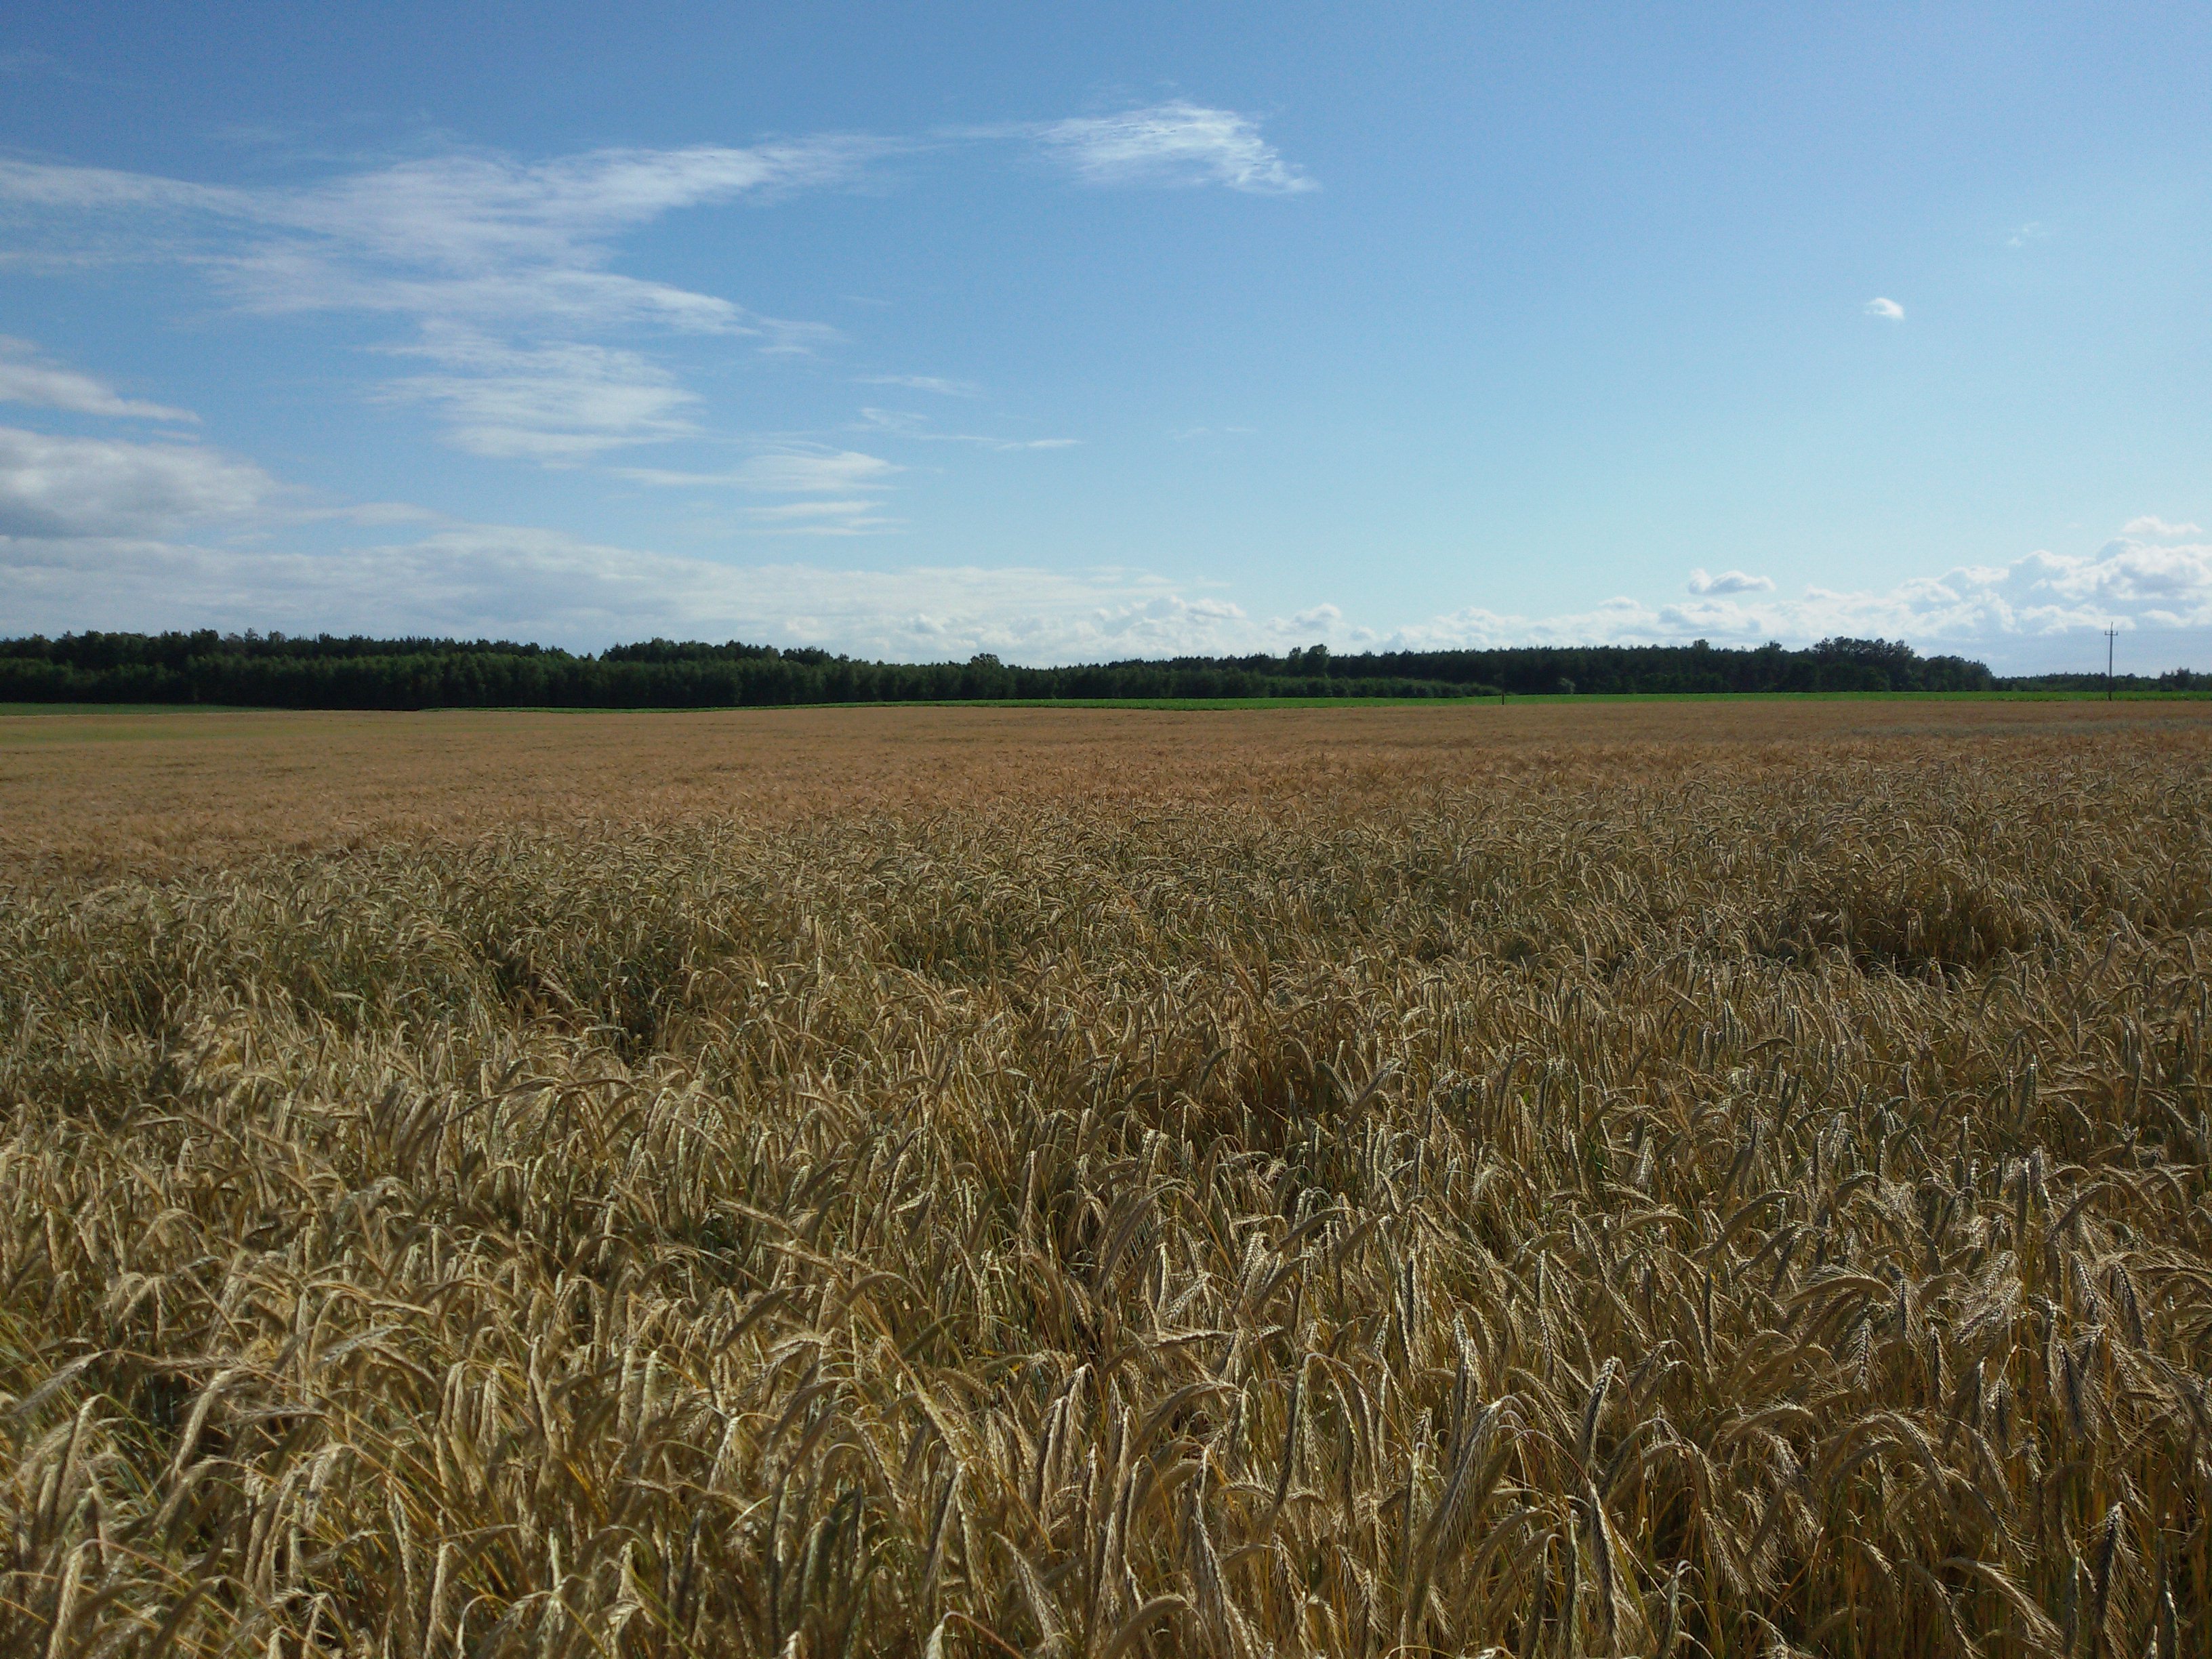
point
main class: Cropland
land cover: Triticale
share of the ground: > 75 %
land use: Agriculture (excluding fallow land and kitchen gardens)
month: July
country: PL
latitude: 52.7290
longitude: 17.6094
